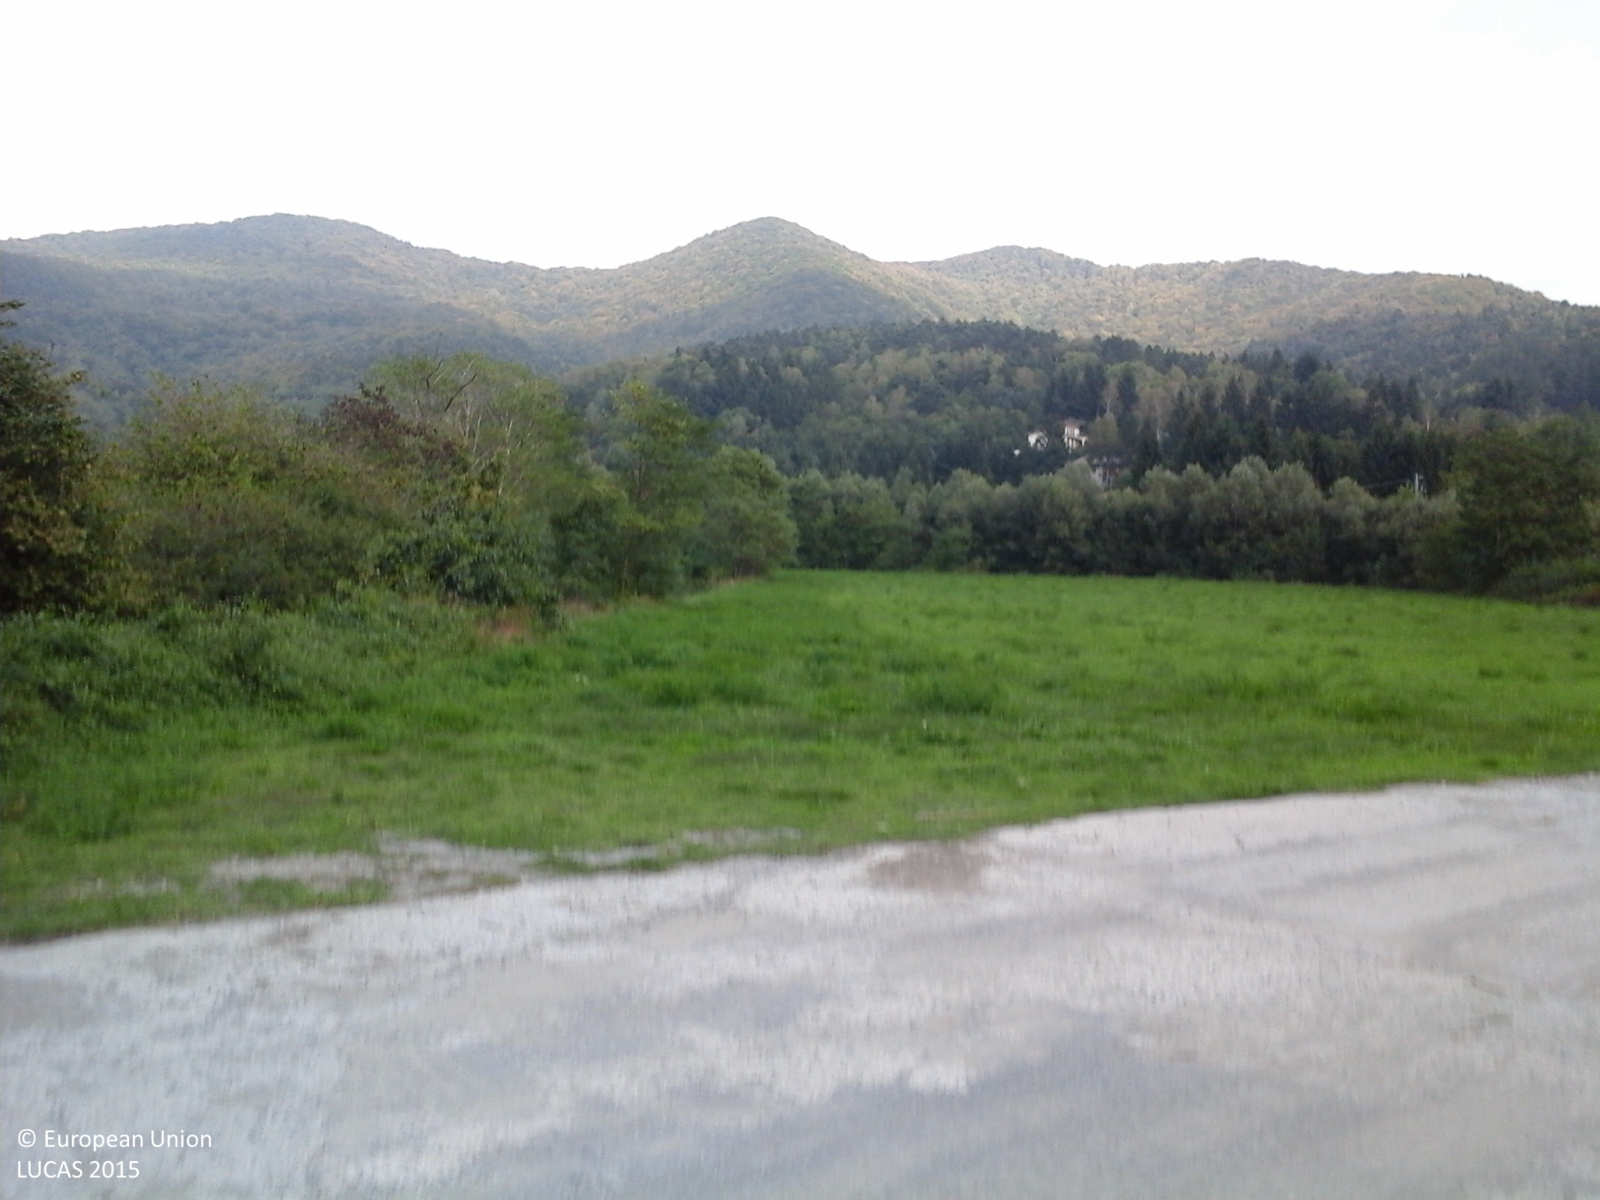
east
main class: Grassland
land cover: Spontaneously vegetated surfaces
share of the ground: > 75 %
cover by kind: herbaceous plants 100 %
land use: Agriculture (excluding fallow land and kitchen gardens)
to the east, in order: Spontaneously vegetated surfaces; Artificial constructions in urban areas; Lucerne; Broadleaved woodland; Inland fresh running water
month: September
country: IT
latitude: 44.2432
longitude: 8.1134
